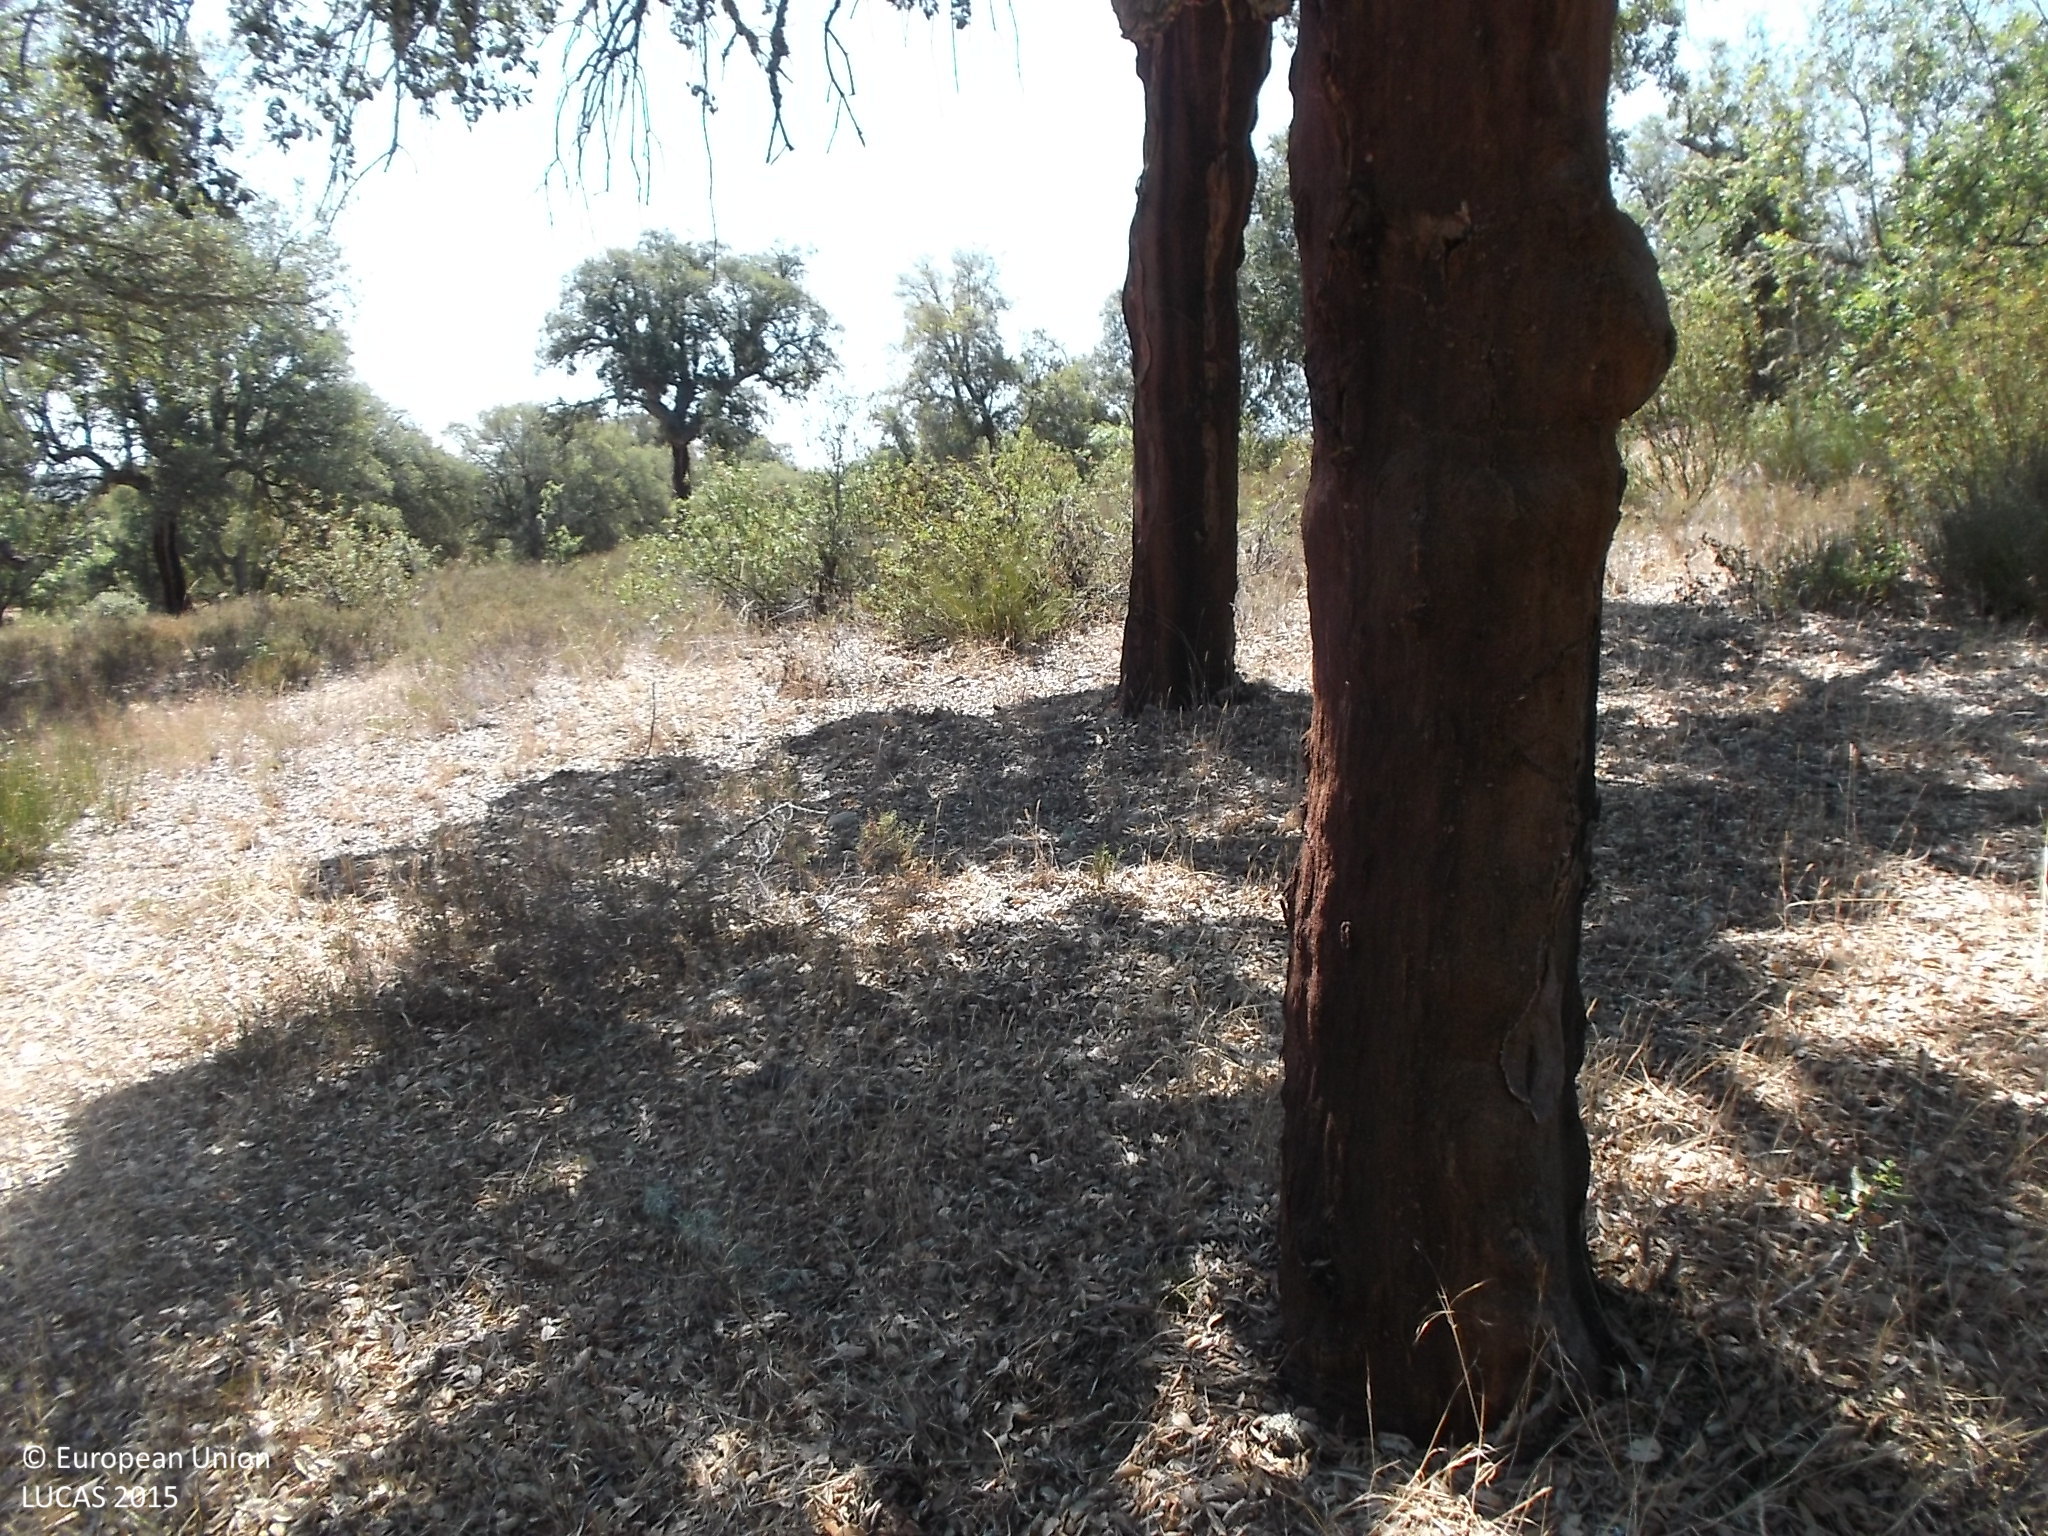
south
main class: Woodland
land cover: Broadleaved woodland
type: broadleaved evergreen forest
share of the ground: 25 - 50 %
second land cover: Shrubland without tree cover
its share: 25 - 50 %
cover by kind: broadleaved forest trees 50 %, shrubs 30 %, herbaceous plants 20 %
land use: Forestry
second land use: Agriculture (excluding fallow land and kitchen gardens)
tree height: < 5 m
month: July
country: ES
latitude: 41.3242
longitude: -5.8443
